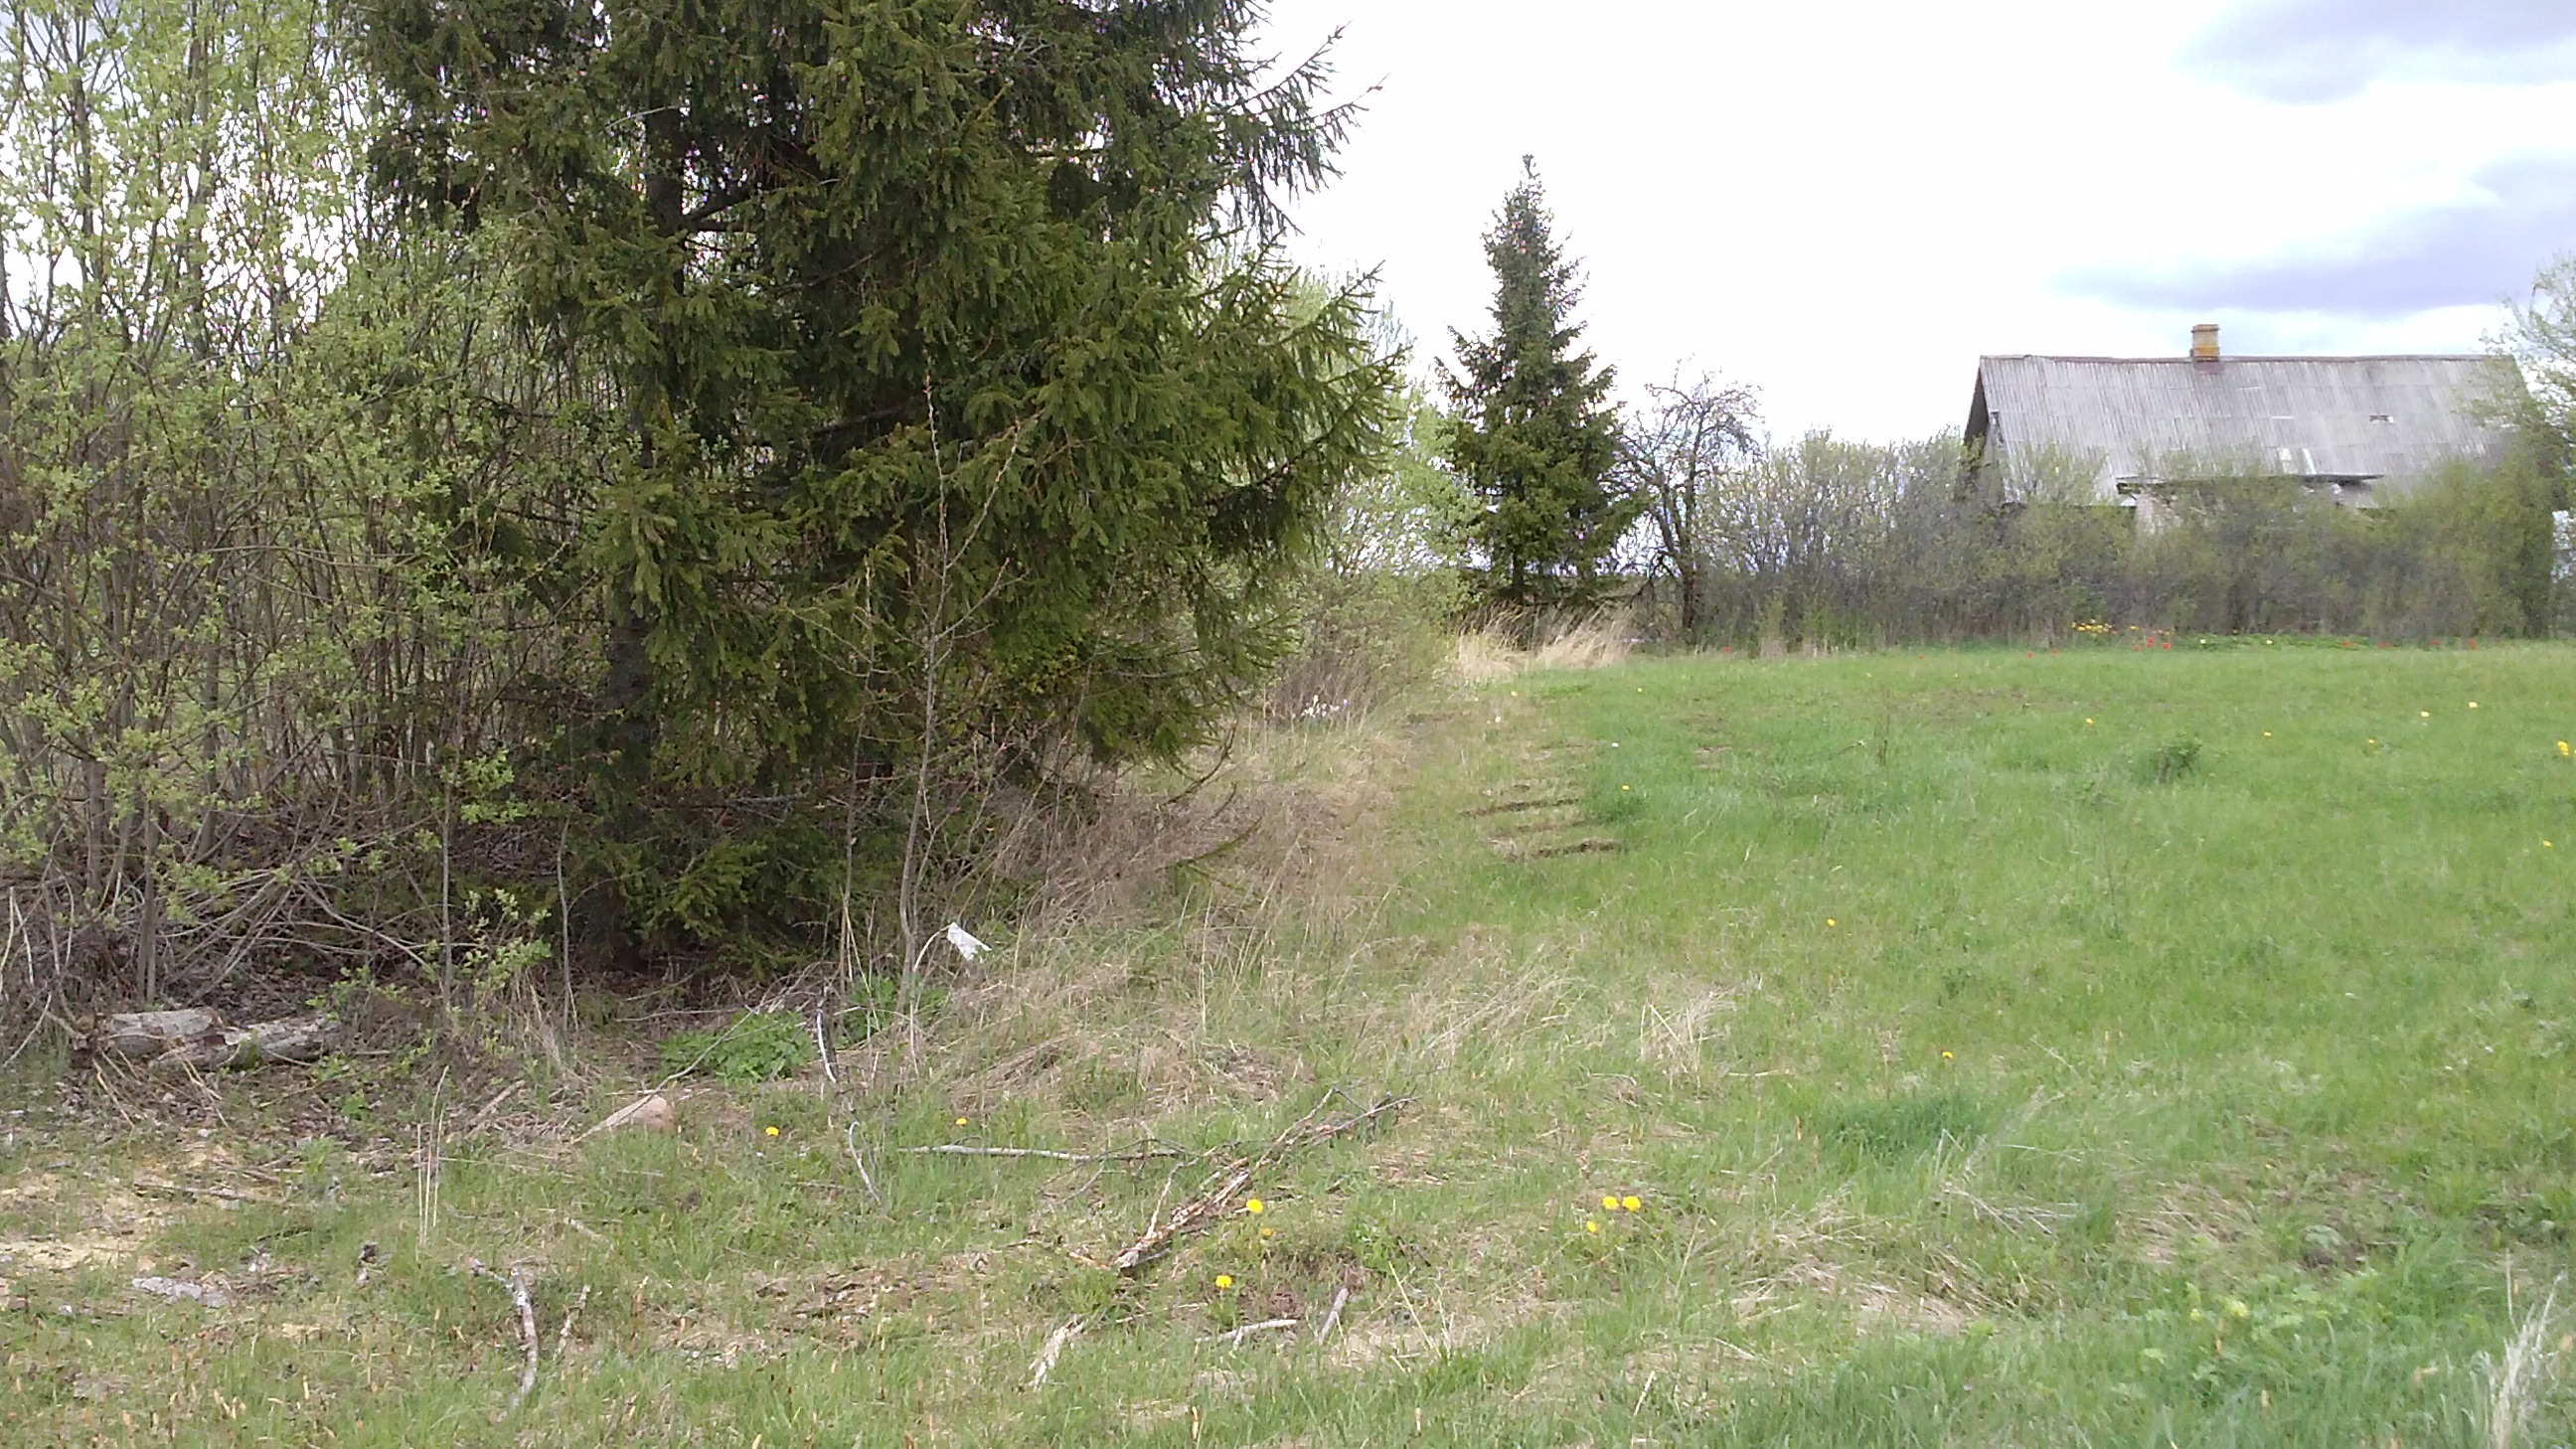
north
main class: Cropland
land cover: Rye
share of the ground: < 10 %
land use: Agriculture (excluding fallow land and kitchen gardens)
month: May
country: LV
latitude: 56.0320
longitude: 27.4308
